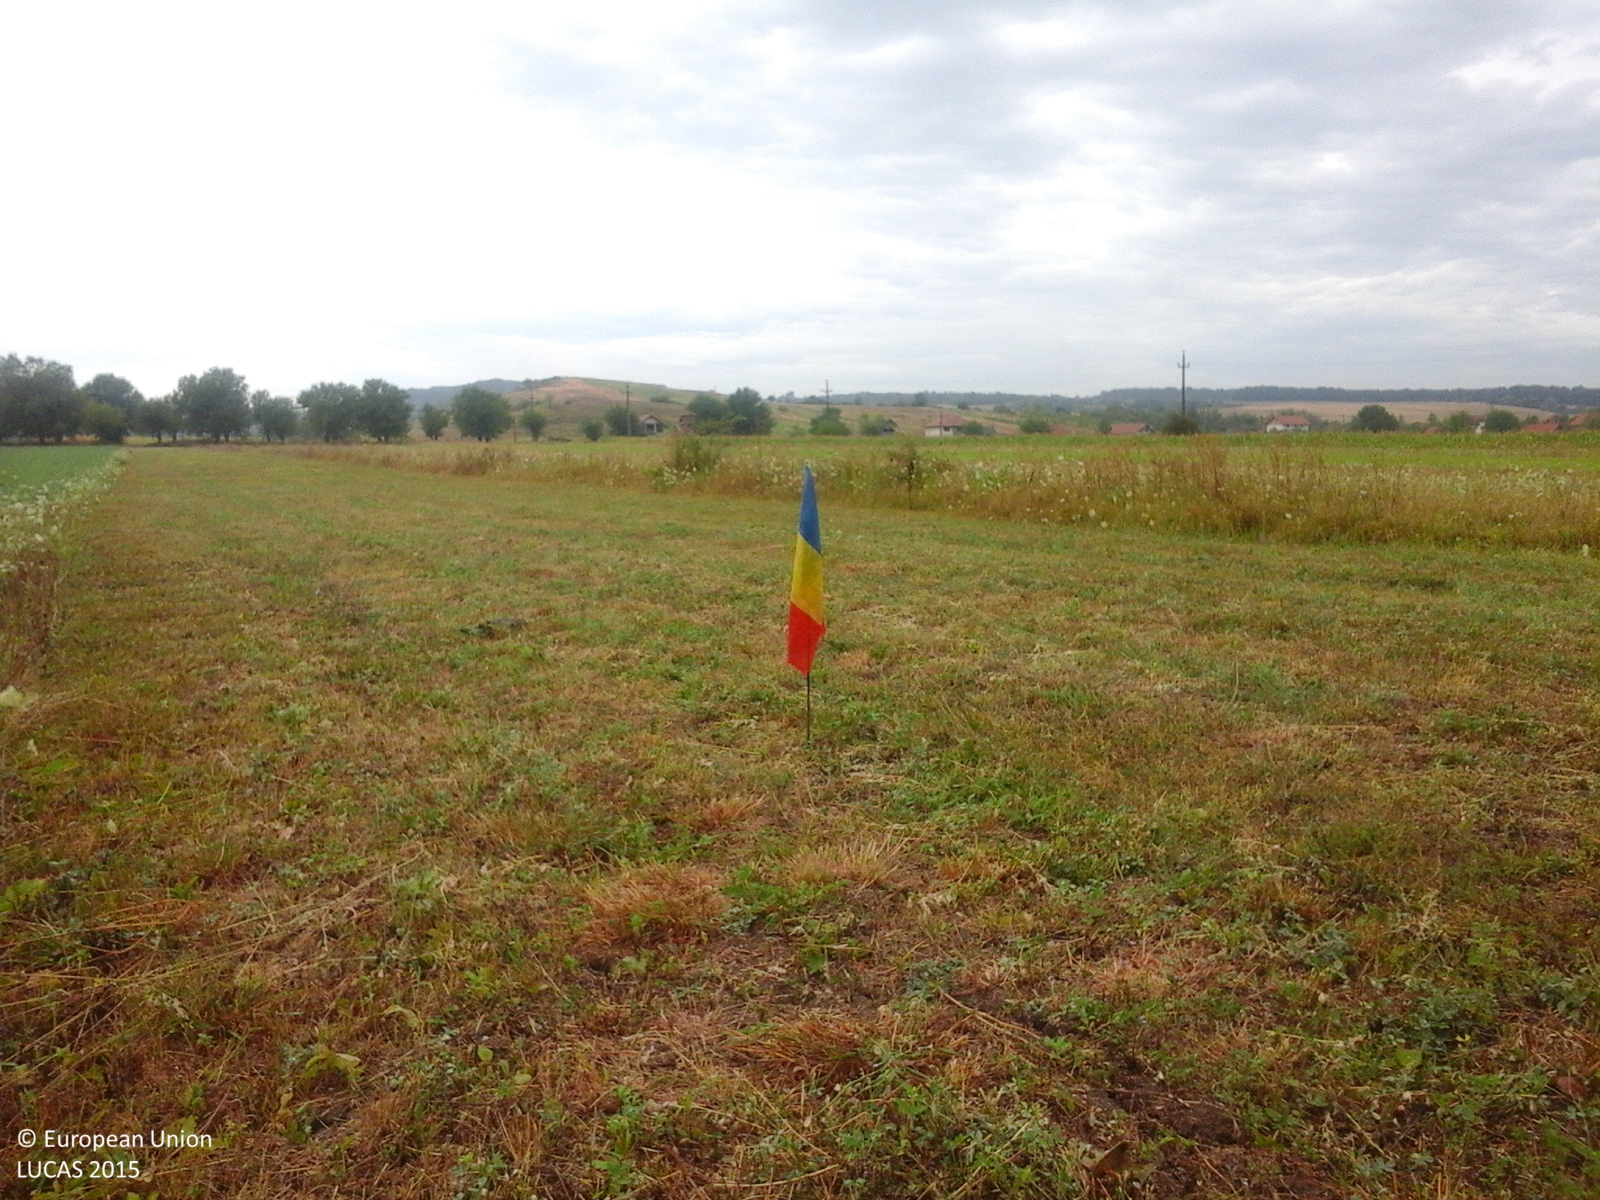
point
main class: Cropland
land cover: Lucerne
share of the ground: > 75 %
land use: Agriculture (excluding fallow land and kitchen gardens)
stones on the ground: < 10 %
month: August
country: RO
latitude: 44.7291
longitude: 22.8867
